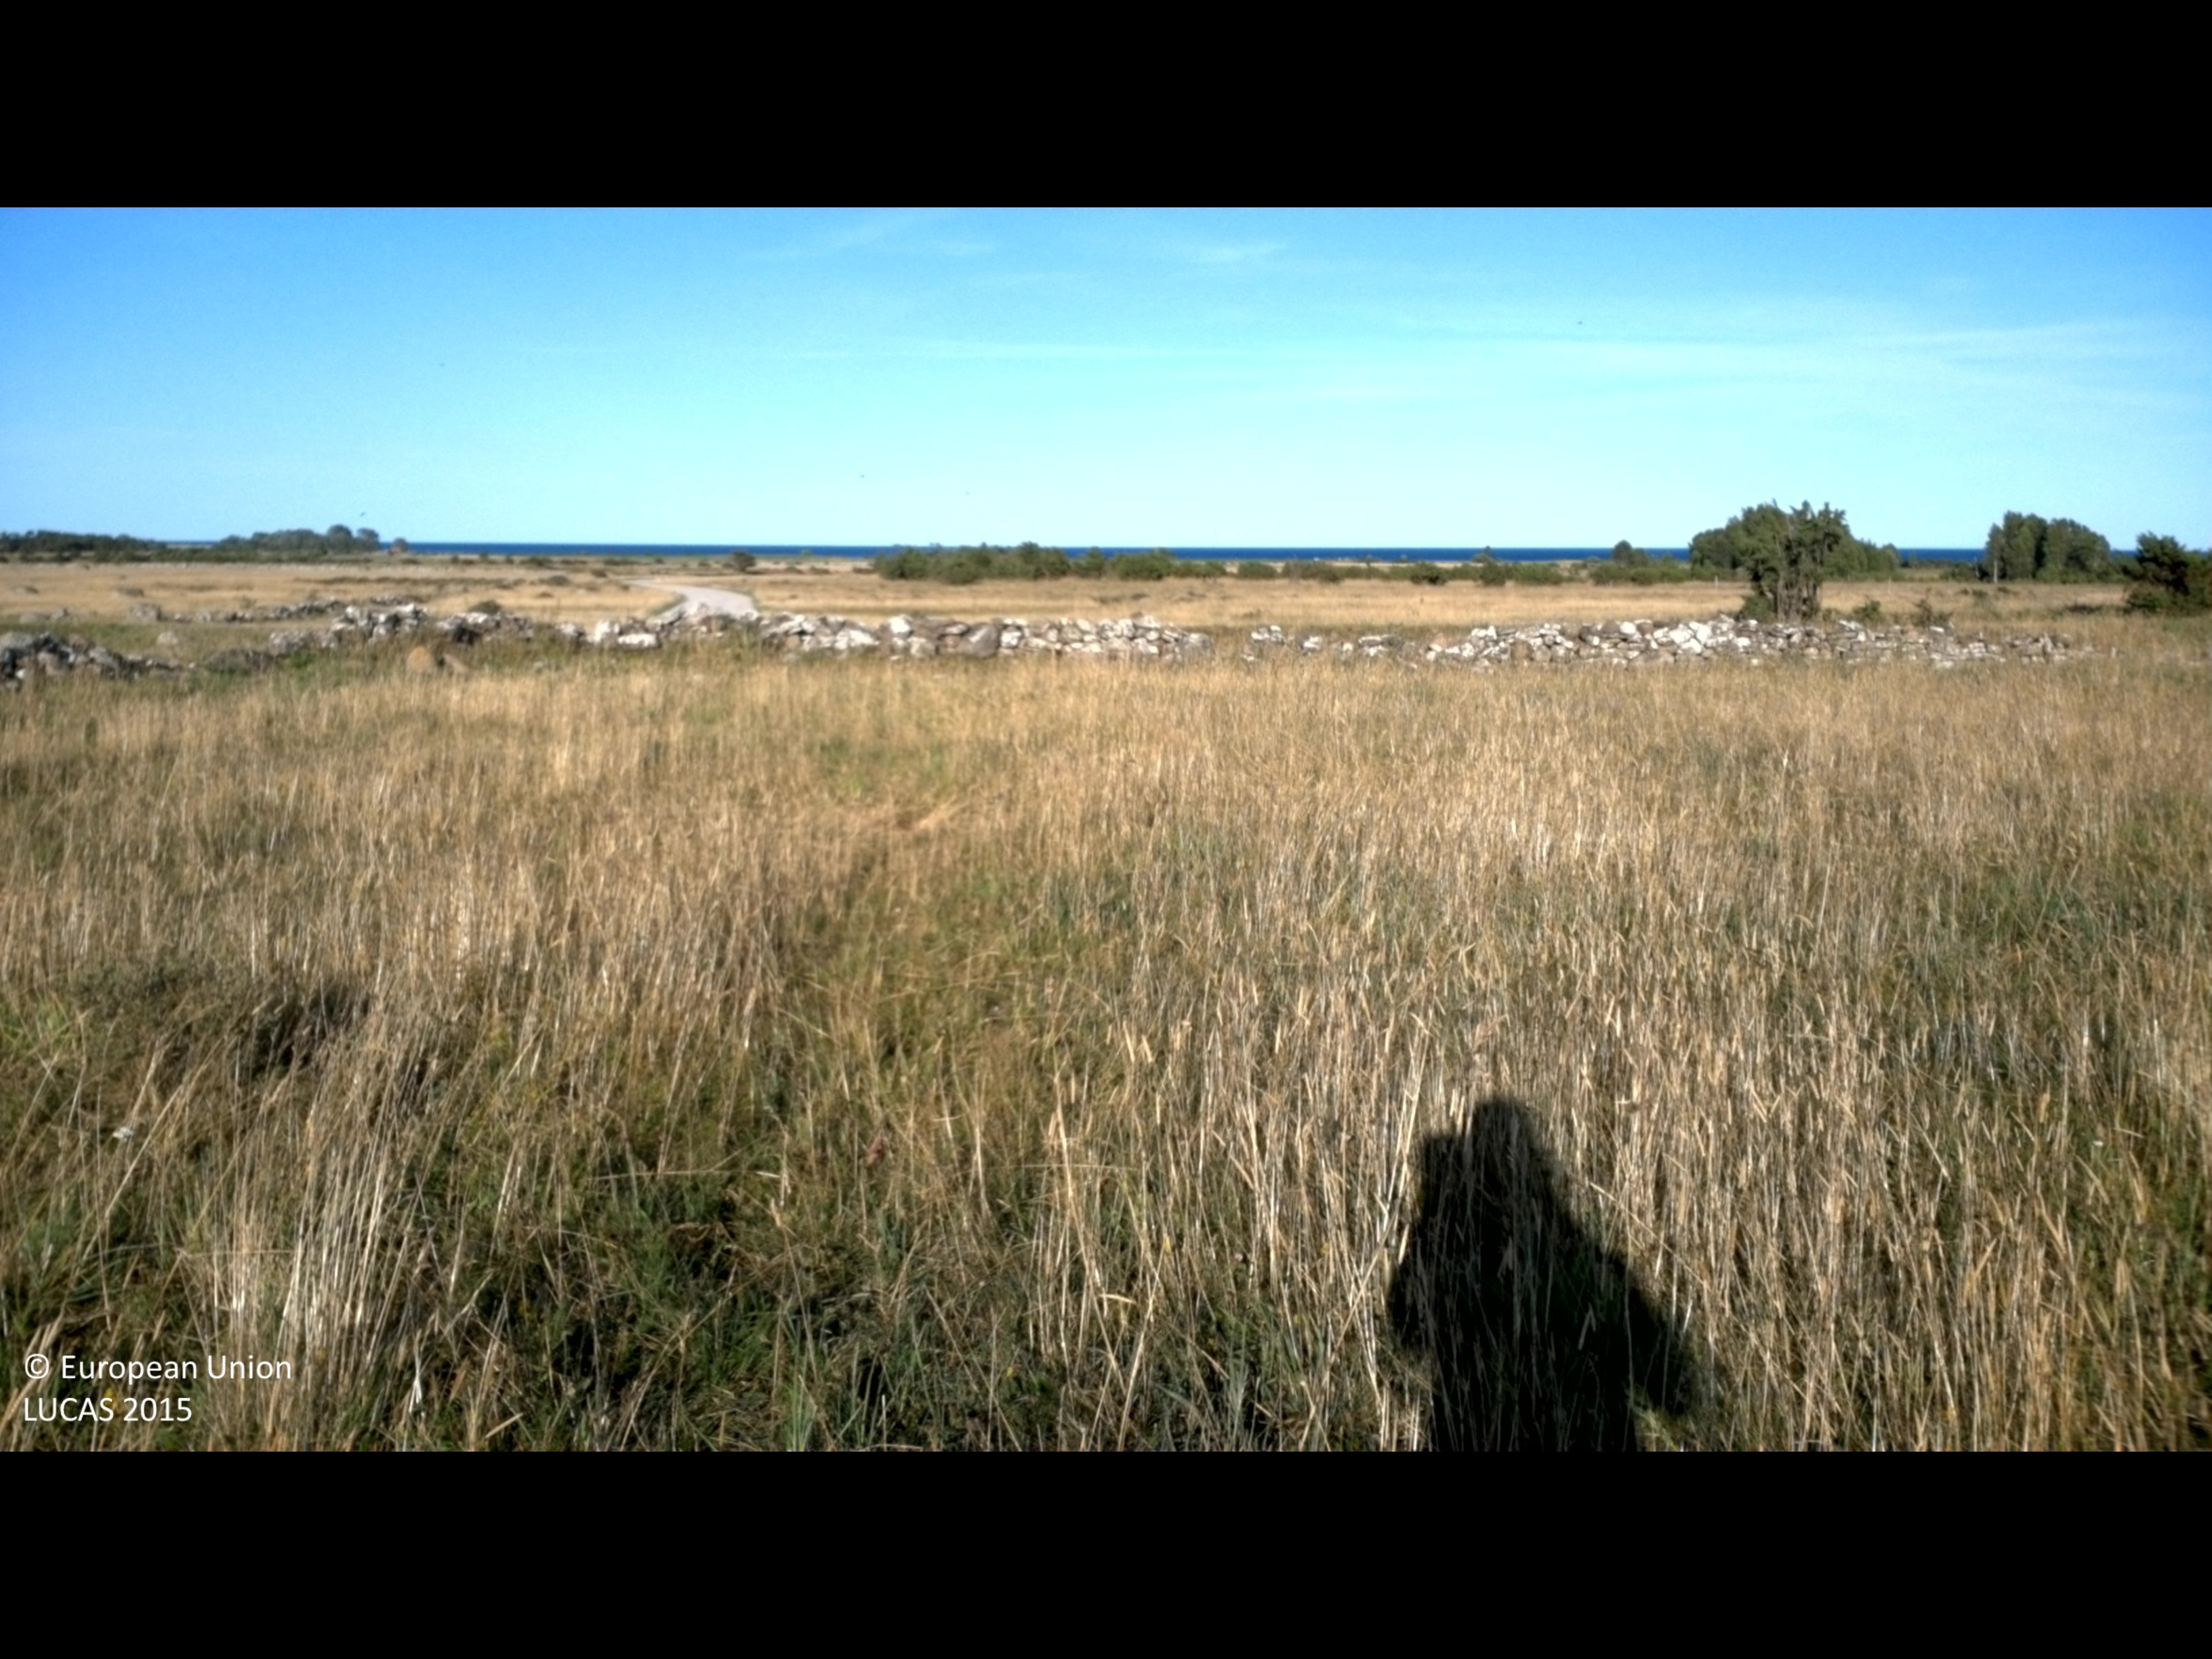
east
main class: Grassland
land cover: Grassland without tree/shrub cover
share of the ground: > 75 %
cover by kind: herbaceous plants 100 %
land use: Agriculture (excluding fallow land and kitchen gardens)
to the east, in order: Grassland without tree/shrub cover; Dry stone walls; Grassland without tree/shrub cover; Shrubland without tree cover; Grassland with sparse tree/shrub cover
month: July
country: SE
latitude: 56.5580
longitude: 16.6240
